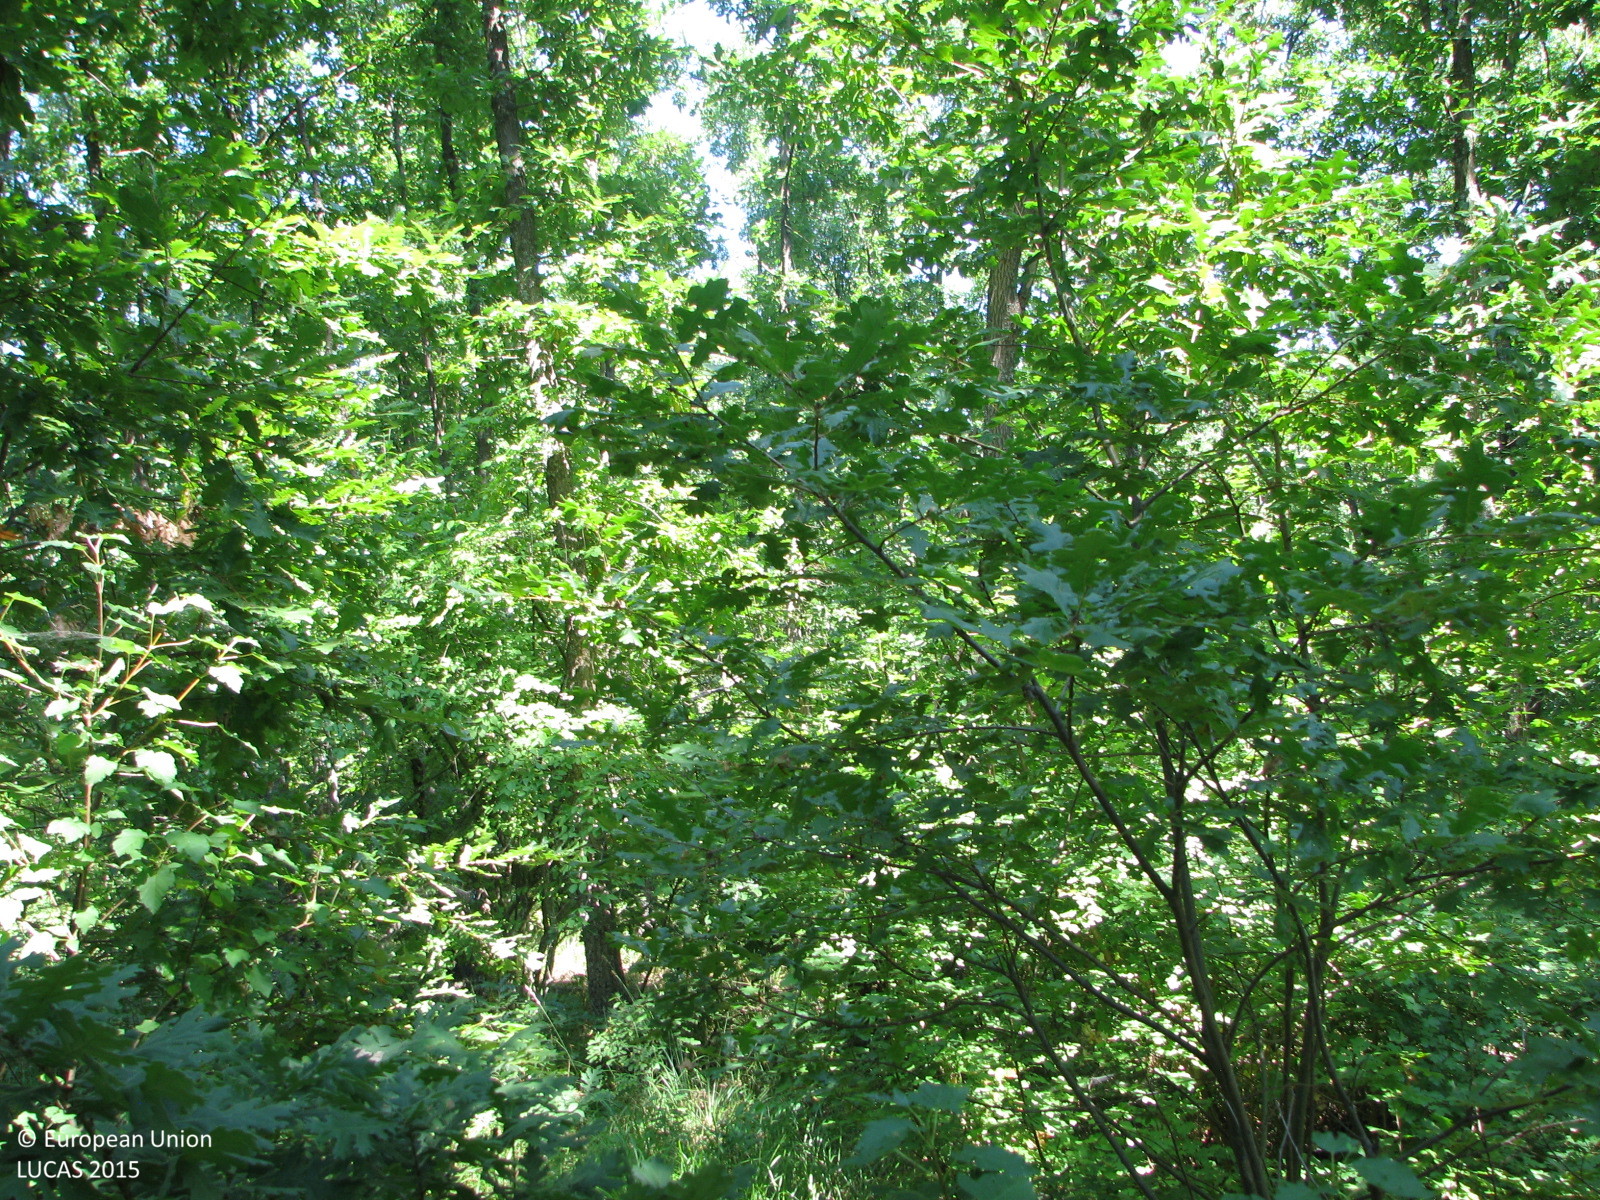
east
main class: Woodland
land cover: Broadleaved woodland
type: thermophilous deciduous forest
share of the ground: 50 - 75 %
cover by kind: broadleaved forest trees 60 %, herbaceous plants 30 %, shrubs 10 %
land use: Forestry
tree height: > 5 m
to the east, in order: Broadleaved woodland; Grassland with sparse tree/shrub cover; Broadleaved woodland
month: July
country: BG
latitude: 42.2631
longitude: 26.8391
